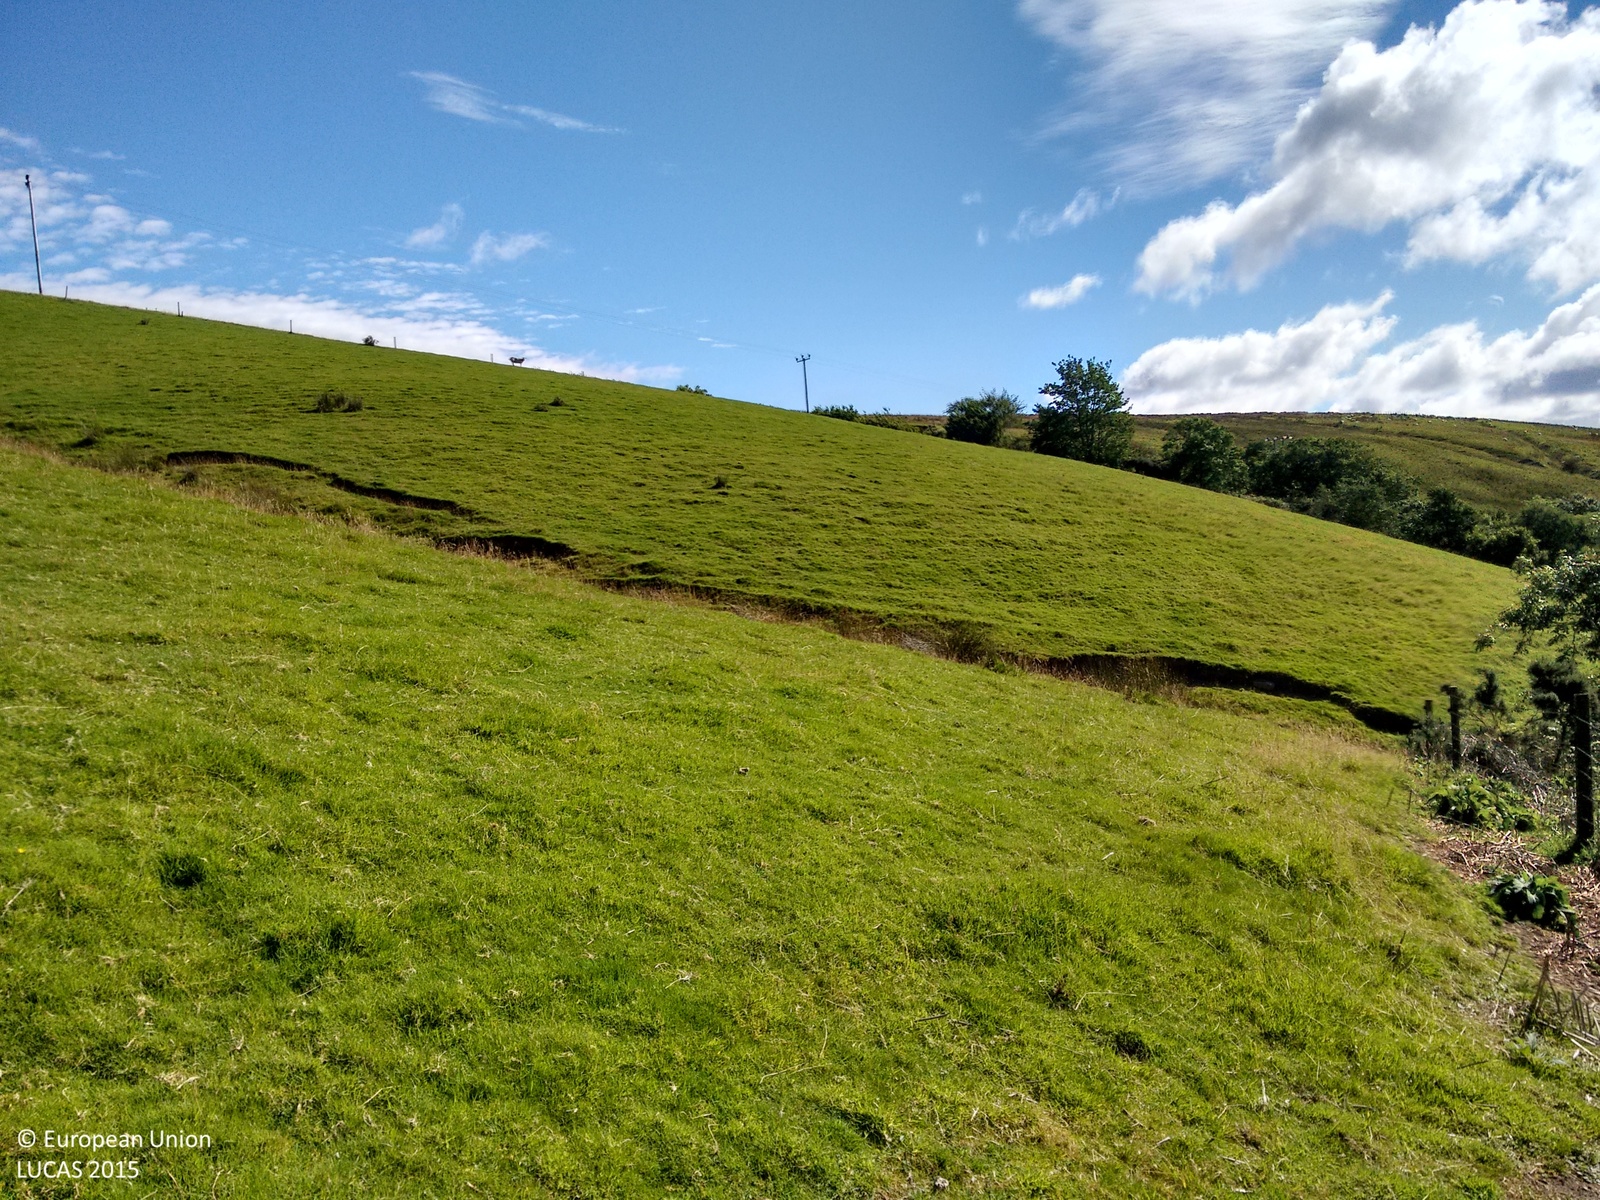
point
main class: Grassland
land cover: Grassland without tree/shrub cover
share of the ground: > 75 %
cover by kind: herbaceous plants 100 %
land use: Agriculture (excluding fallow land and kitchen gardens)
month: September
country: GB
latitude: 55.1562
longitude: -4.8139
